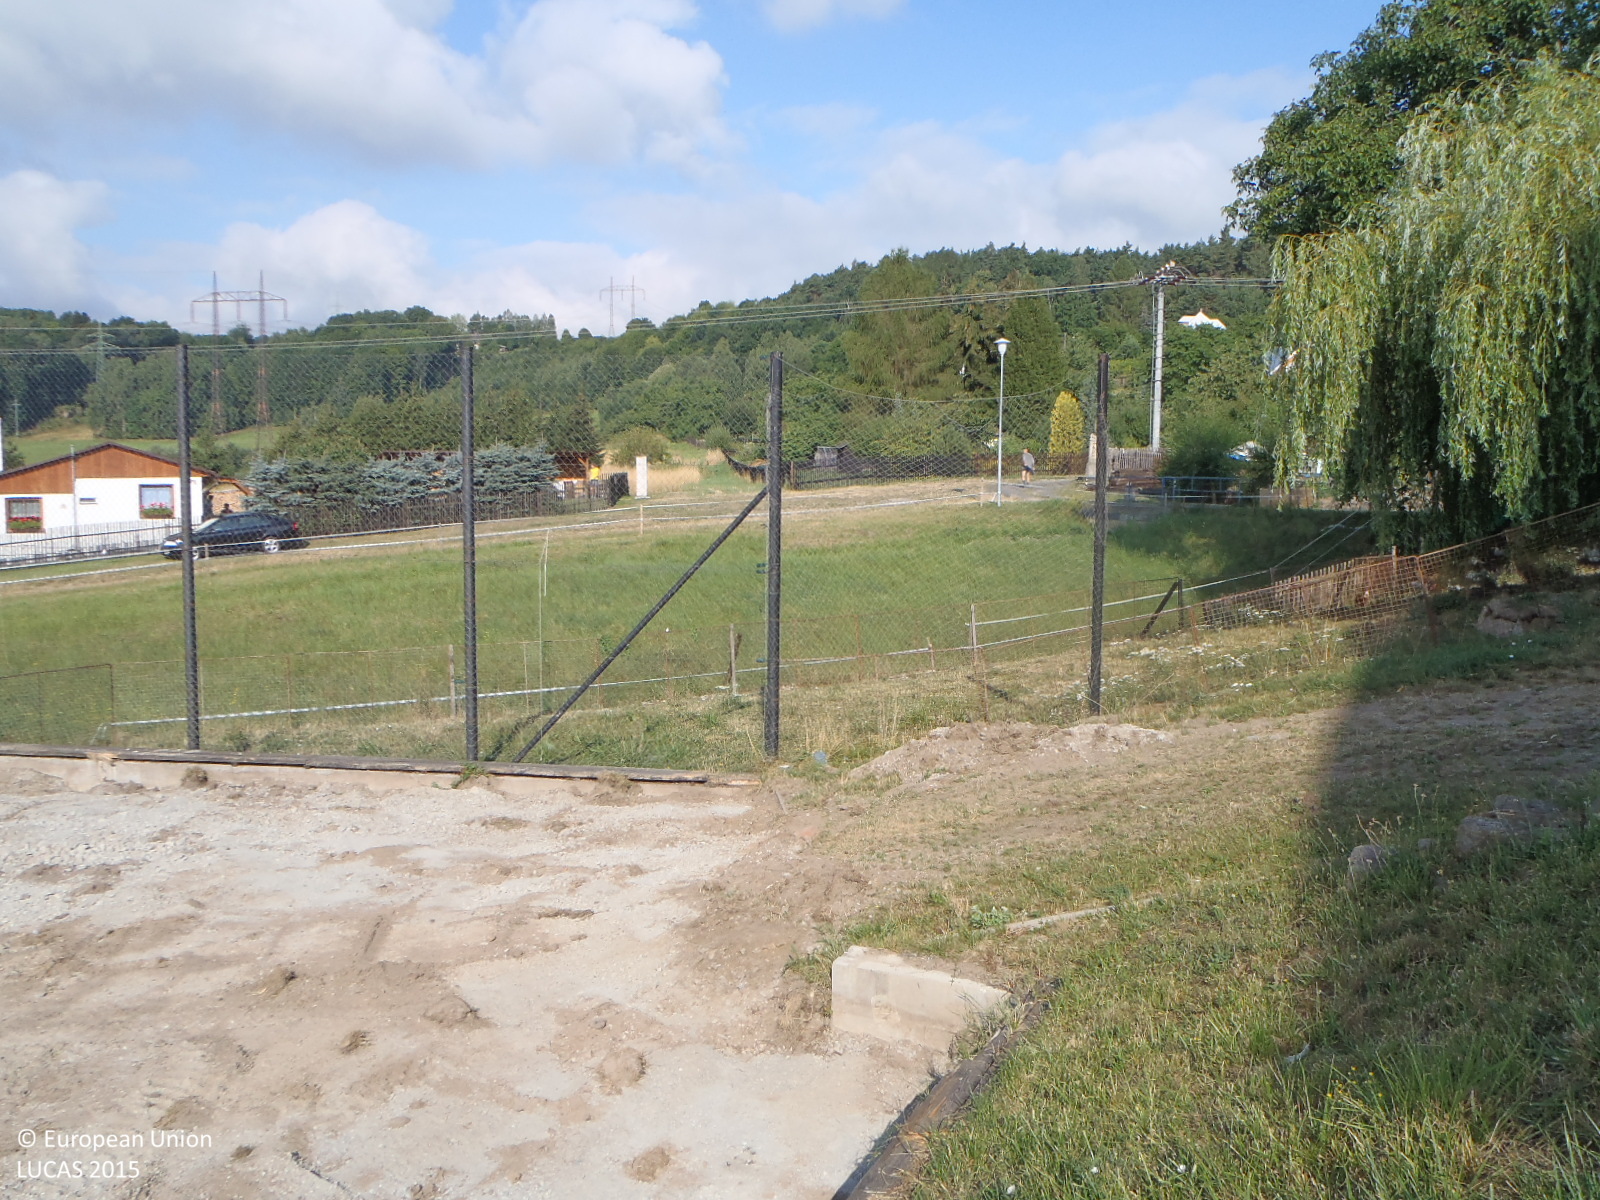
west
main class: Grassland
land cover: Grassland without tree/shrub cover
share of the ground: > 75 %
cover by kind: herbaceous plants 100 %
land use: Community services
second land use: Sport
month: August
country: CZ
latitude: 50.6543
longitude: 14.4856
